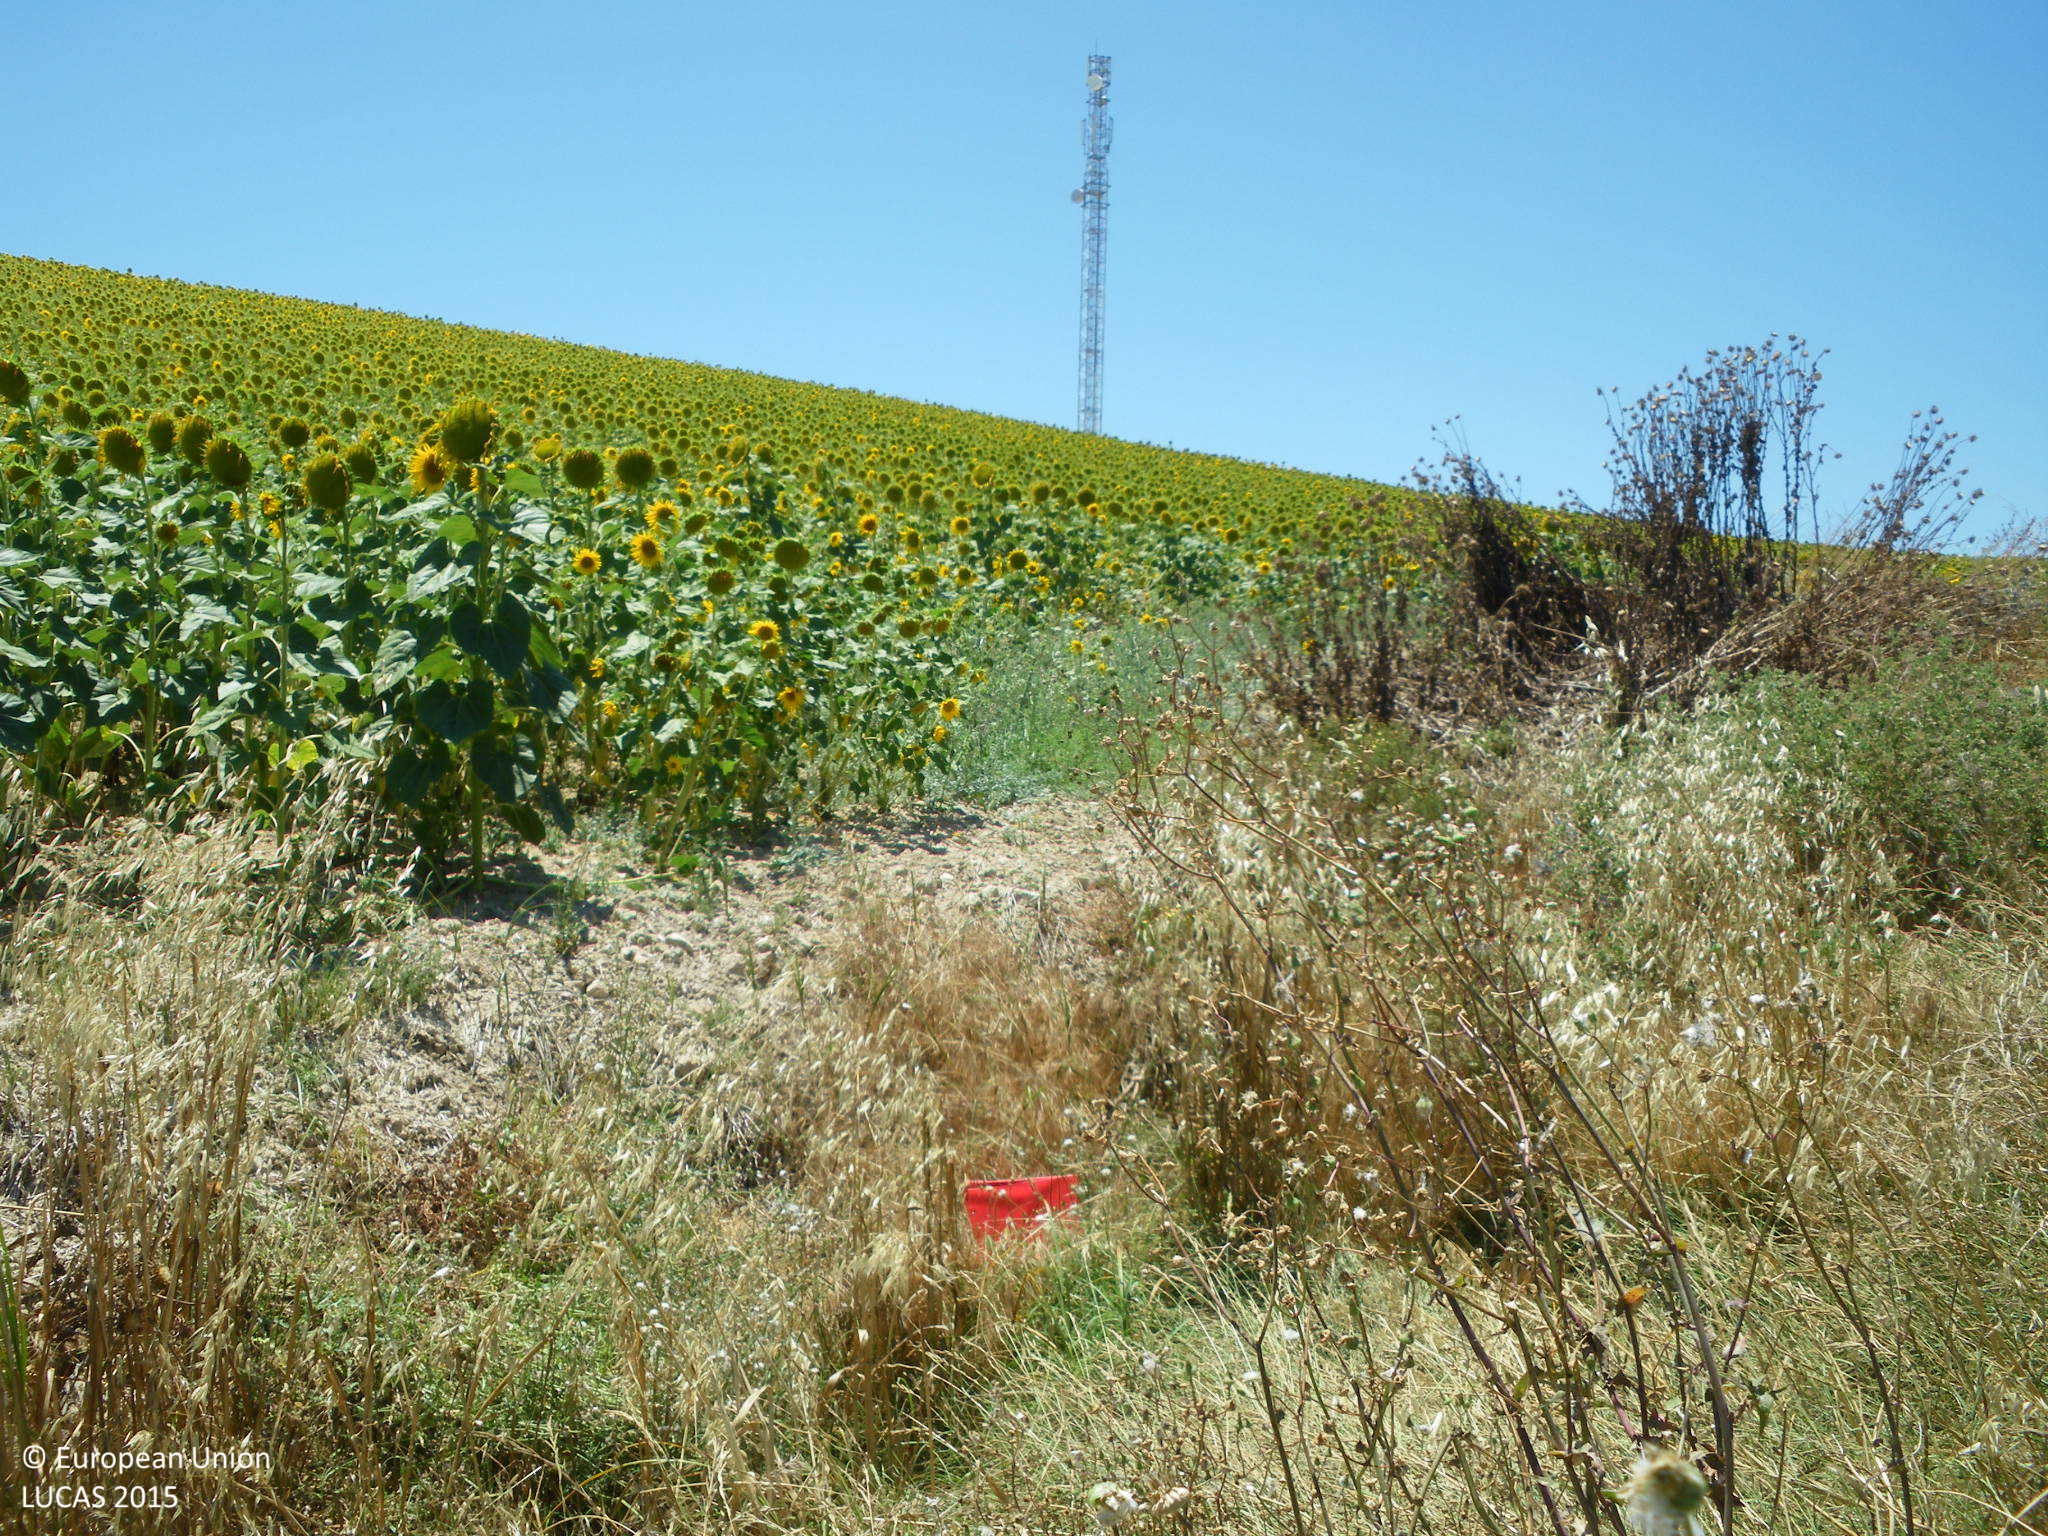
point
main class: Grassland
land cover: Grassland without tree/shrub cover
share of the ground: > 75 %
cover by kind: herbaceous plants 100 %
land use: Semi-natural and natural areas not in use
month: June
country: ES
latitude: 36.9080
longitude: -5.7345
